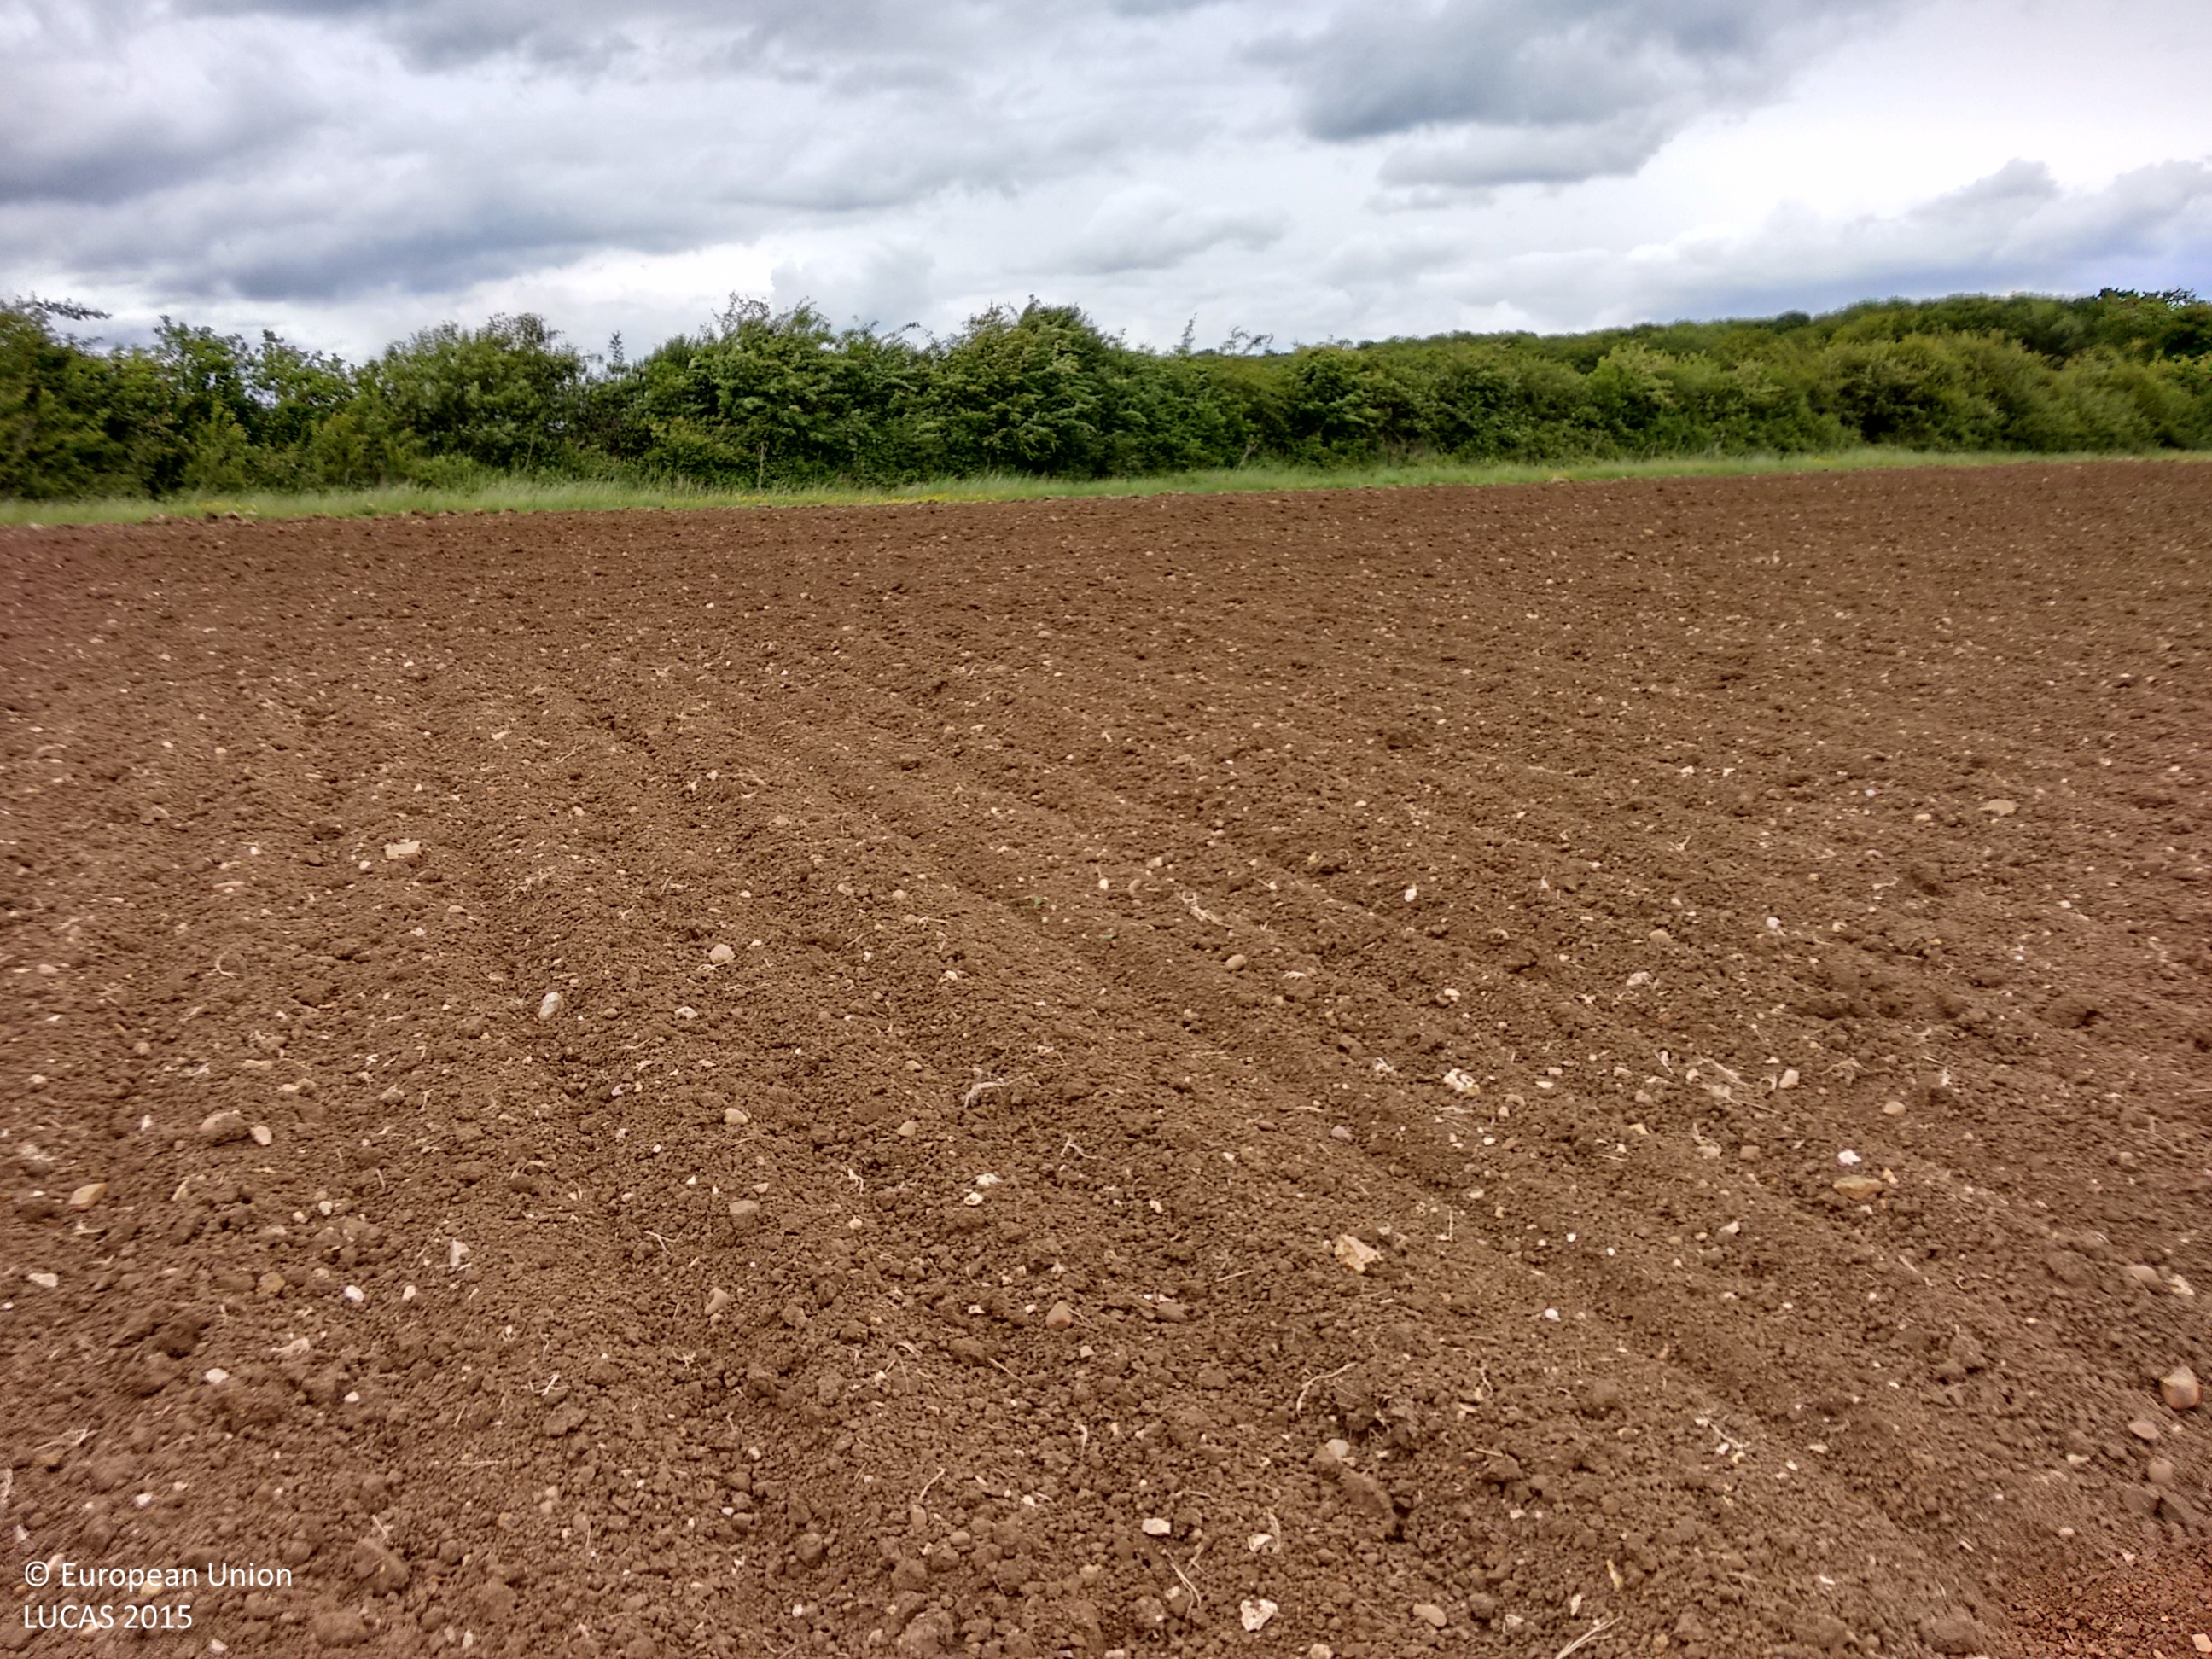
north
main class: Cropland
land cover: Dry pulses
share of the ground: < 10 %
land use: Agriculture (excluding fallow land and kitchen gardens)
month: June
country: GB
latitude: 52.2258
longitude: -0.6242
